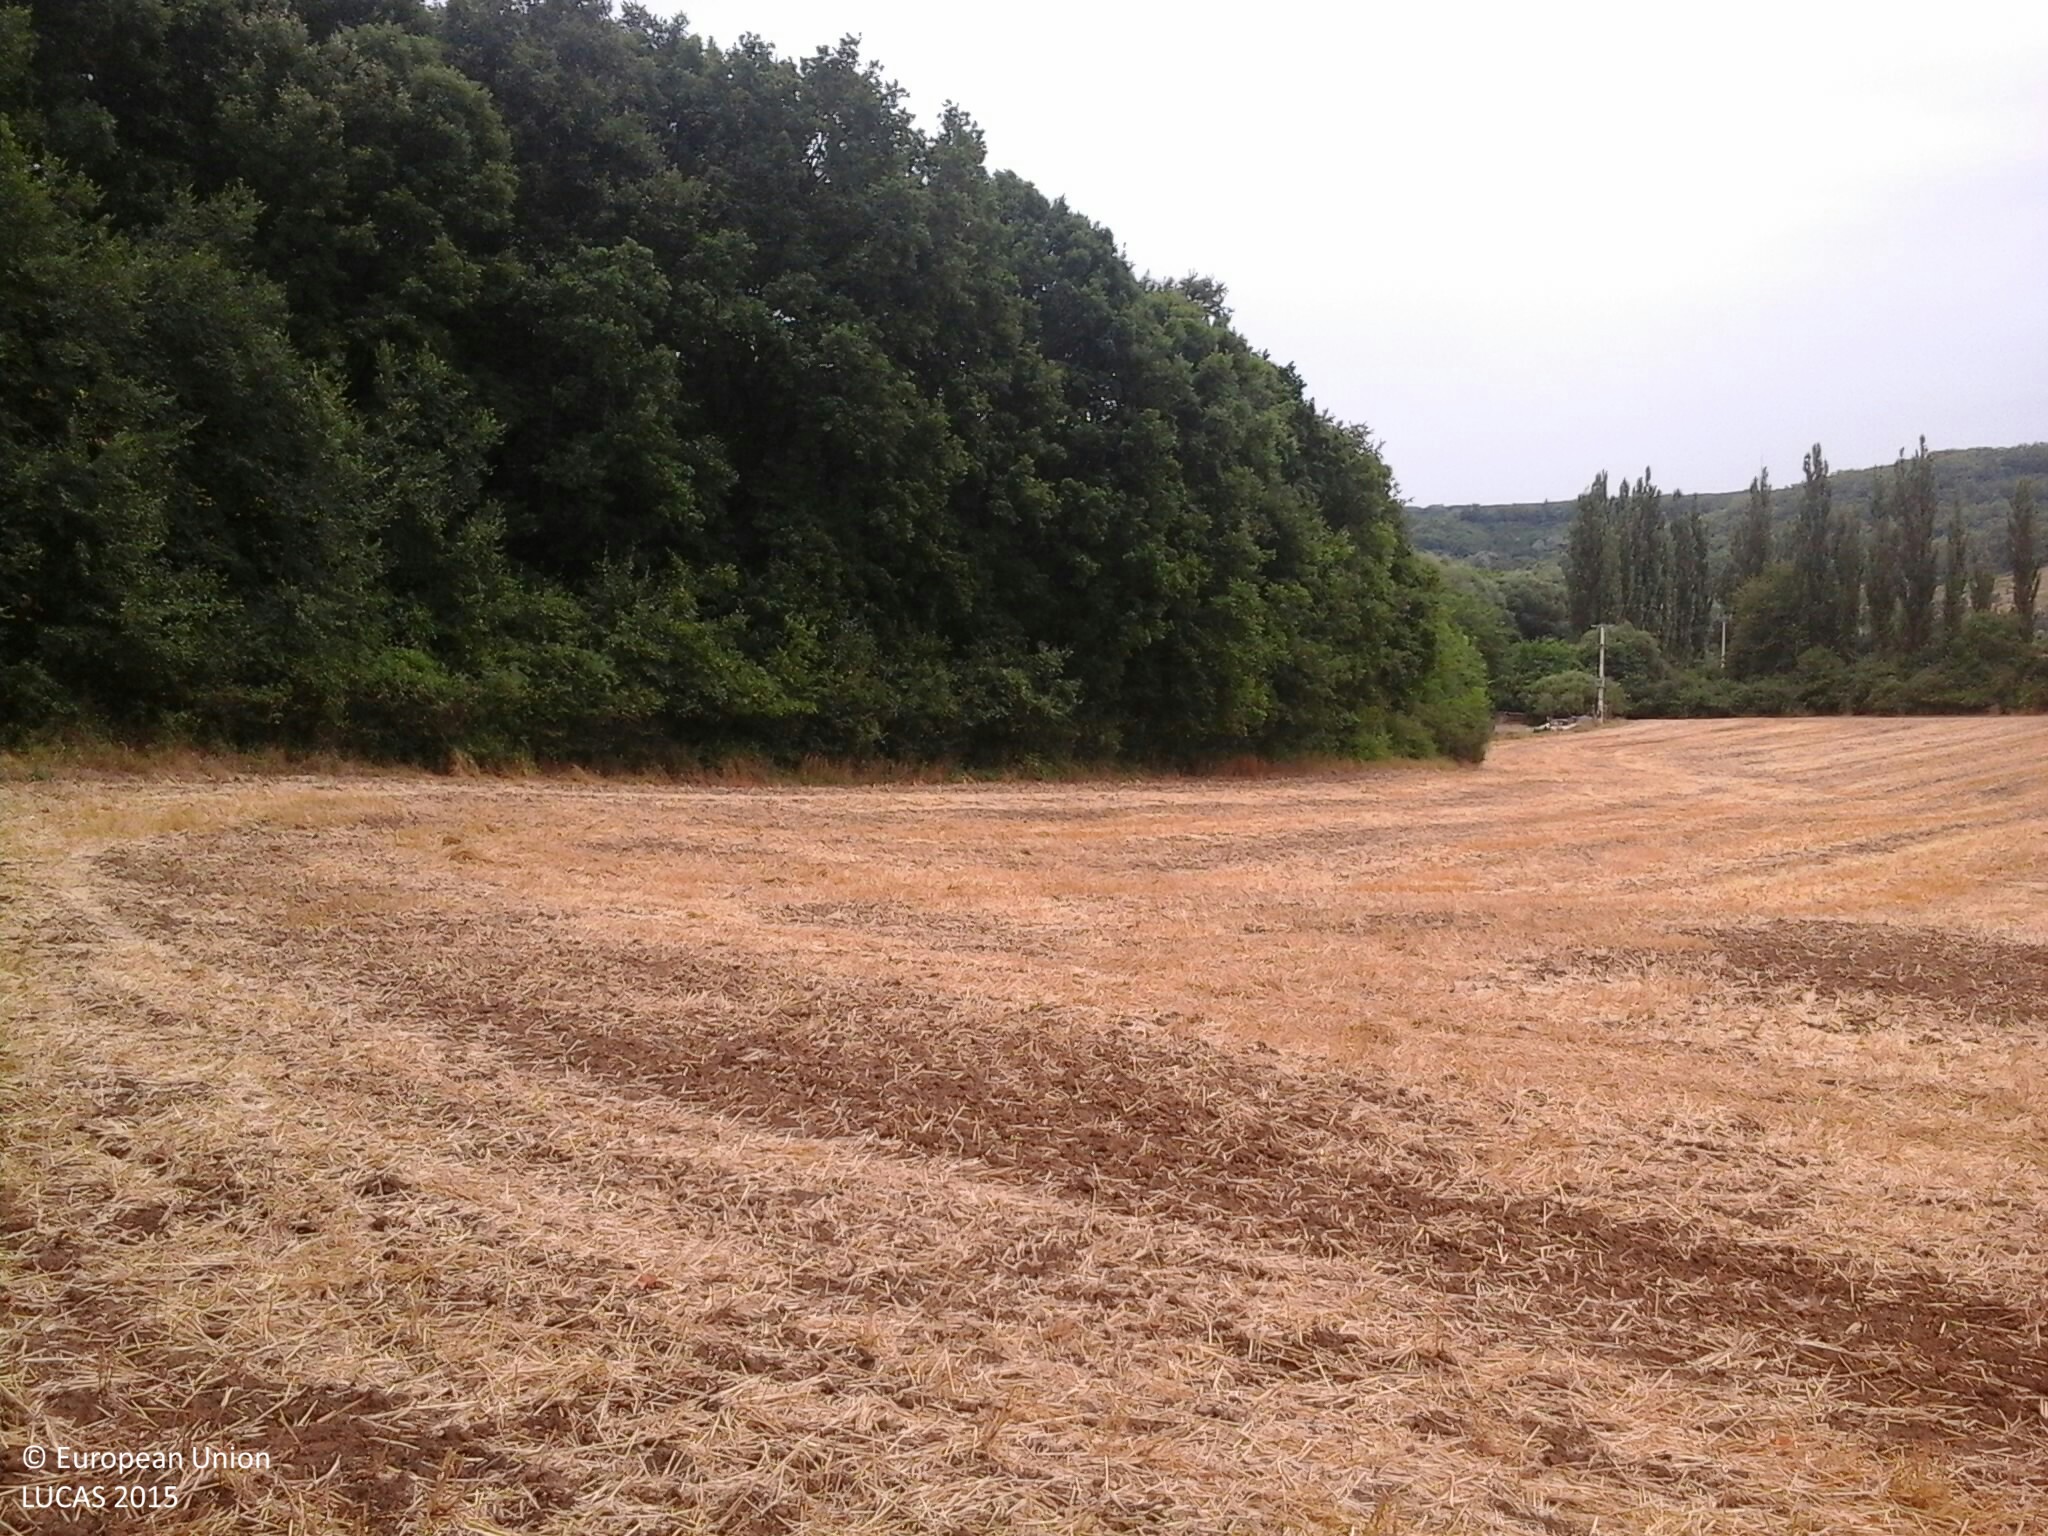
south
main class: Woodland
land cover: Broadleaved woodland
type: mesophytic deciduous forest
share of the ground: > 75 %
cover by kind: broadleaved forest trees 100 %
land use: Forestry
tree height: > 5 m
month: July
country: HU
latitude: 47.9184
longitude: 19.3217
